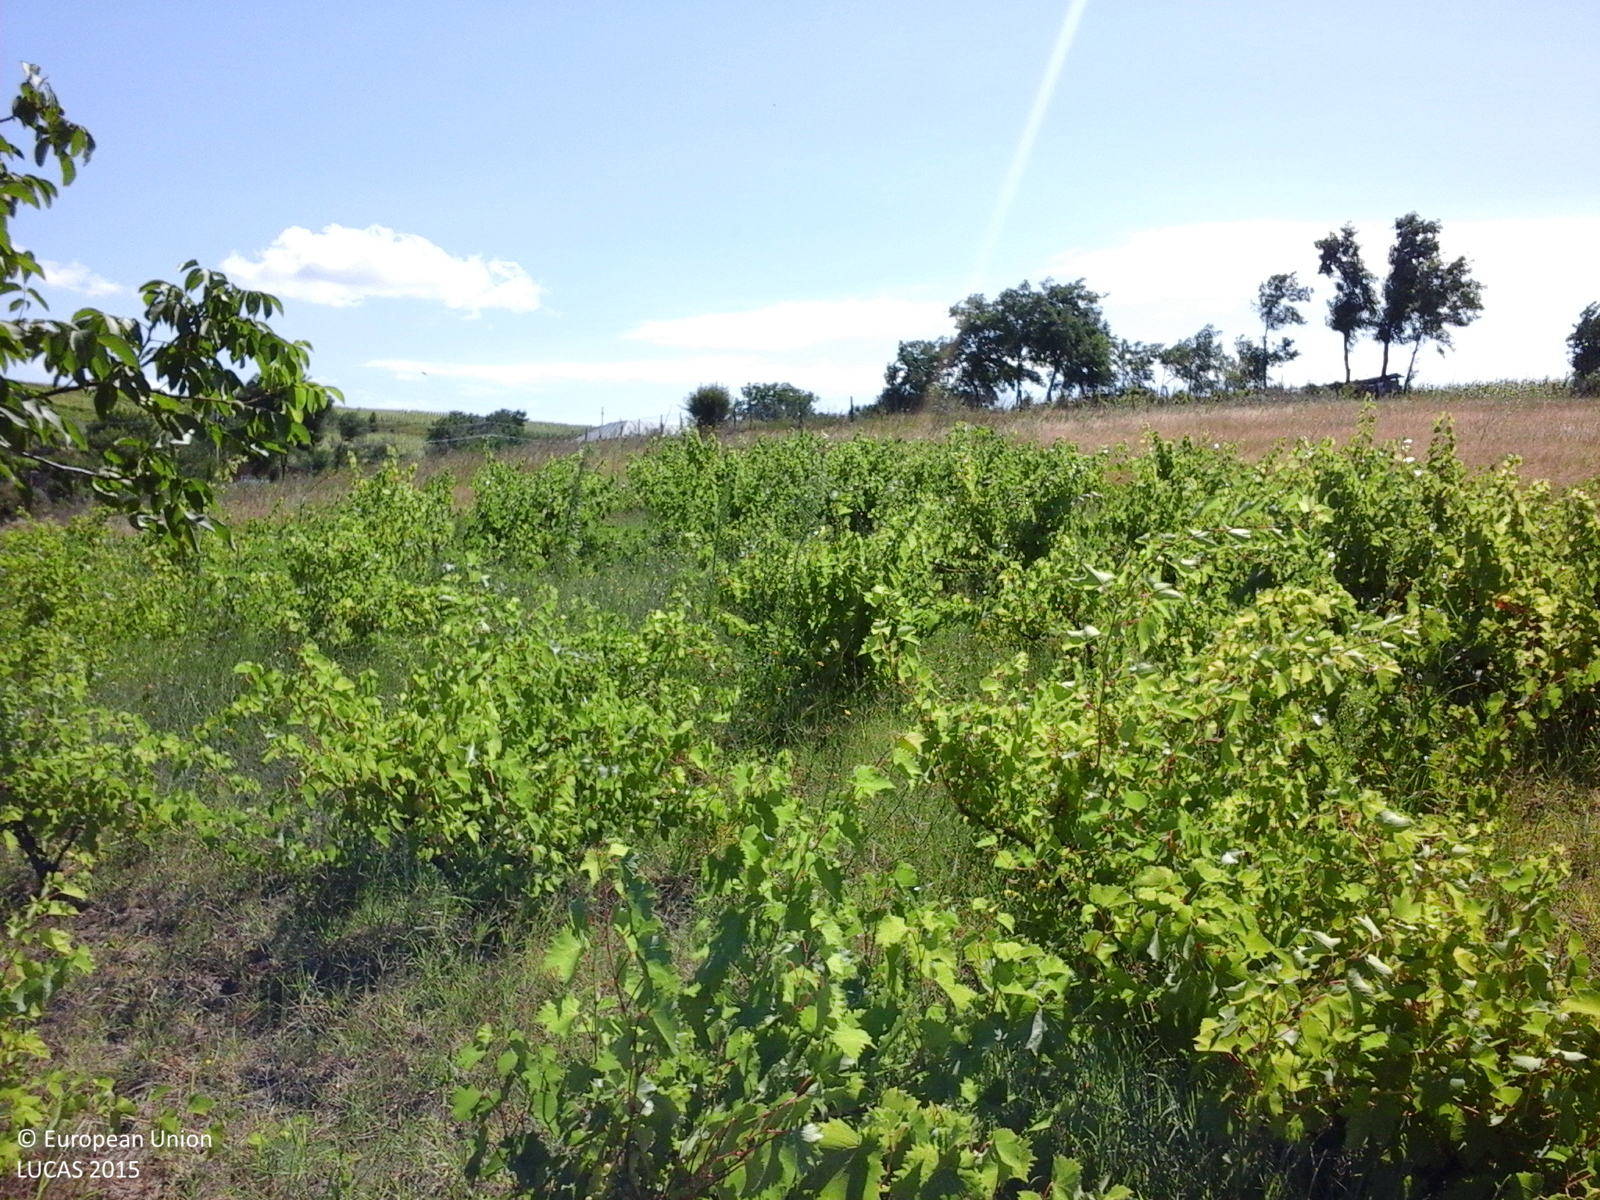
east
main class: Cropland
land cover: Vineyards
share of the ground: > 75 %
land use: Agriculture (excluding fallow land and kitchen gardens)
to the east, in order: Vineyards; Arable land (only in case pi); Grassland without tree/shrub cover; Fences; Grassland without tree/shrub cover; Fences; Grass margins; Artificial constructions in urban areas; Electric lines; Artificial constructions in urban areas; Maize
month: July
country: RO
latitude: 45.9782
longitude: 27.7321
